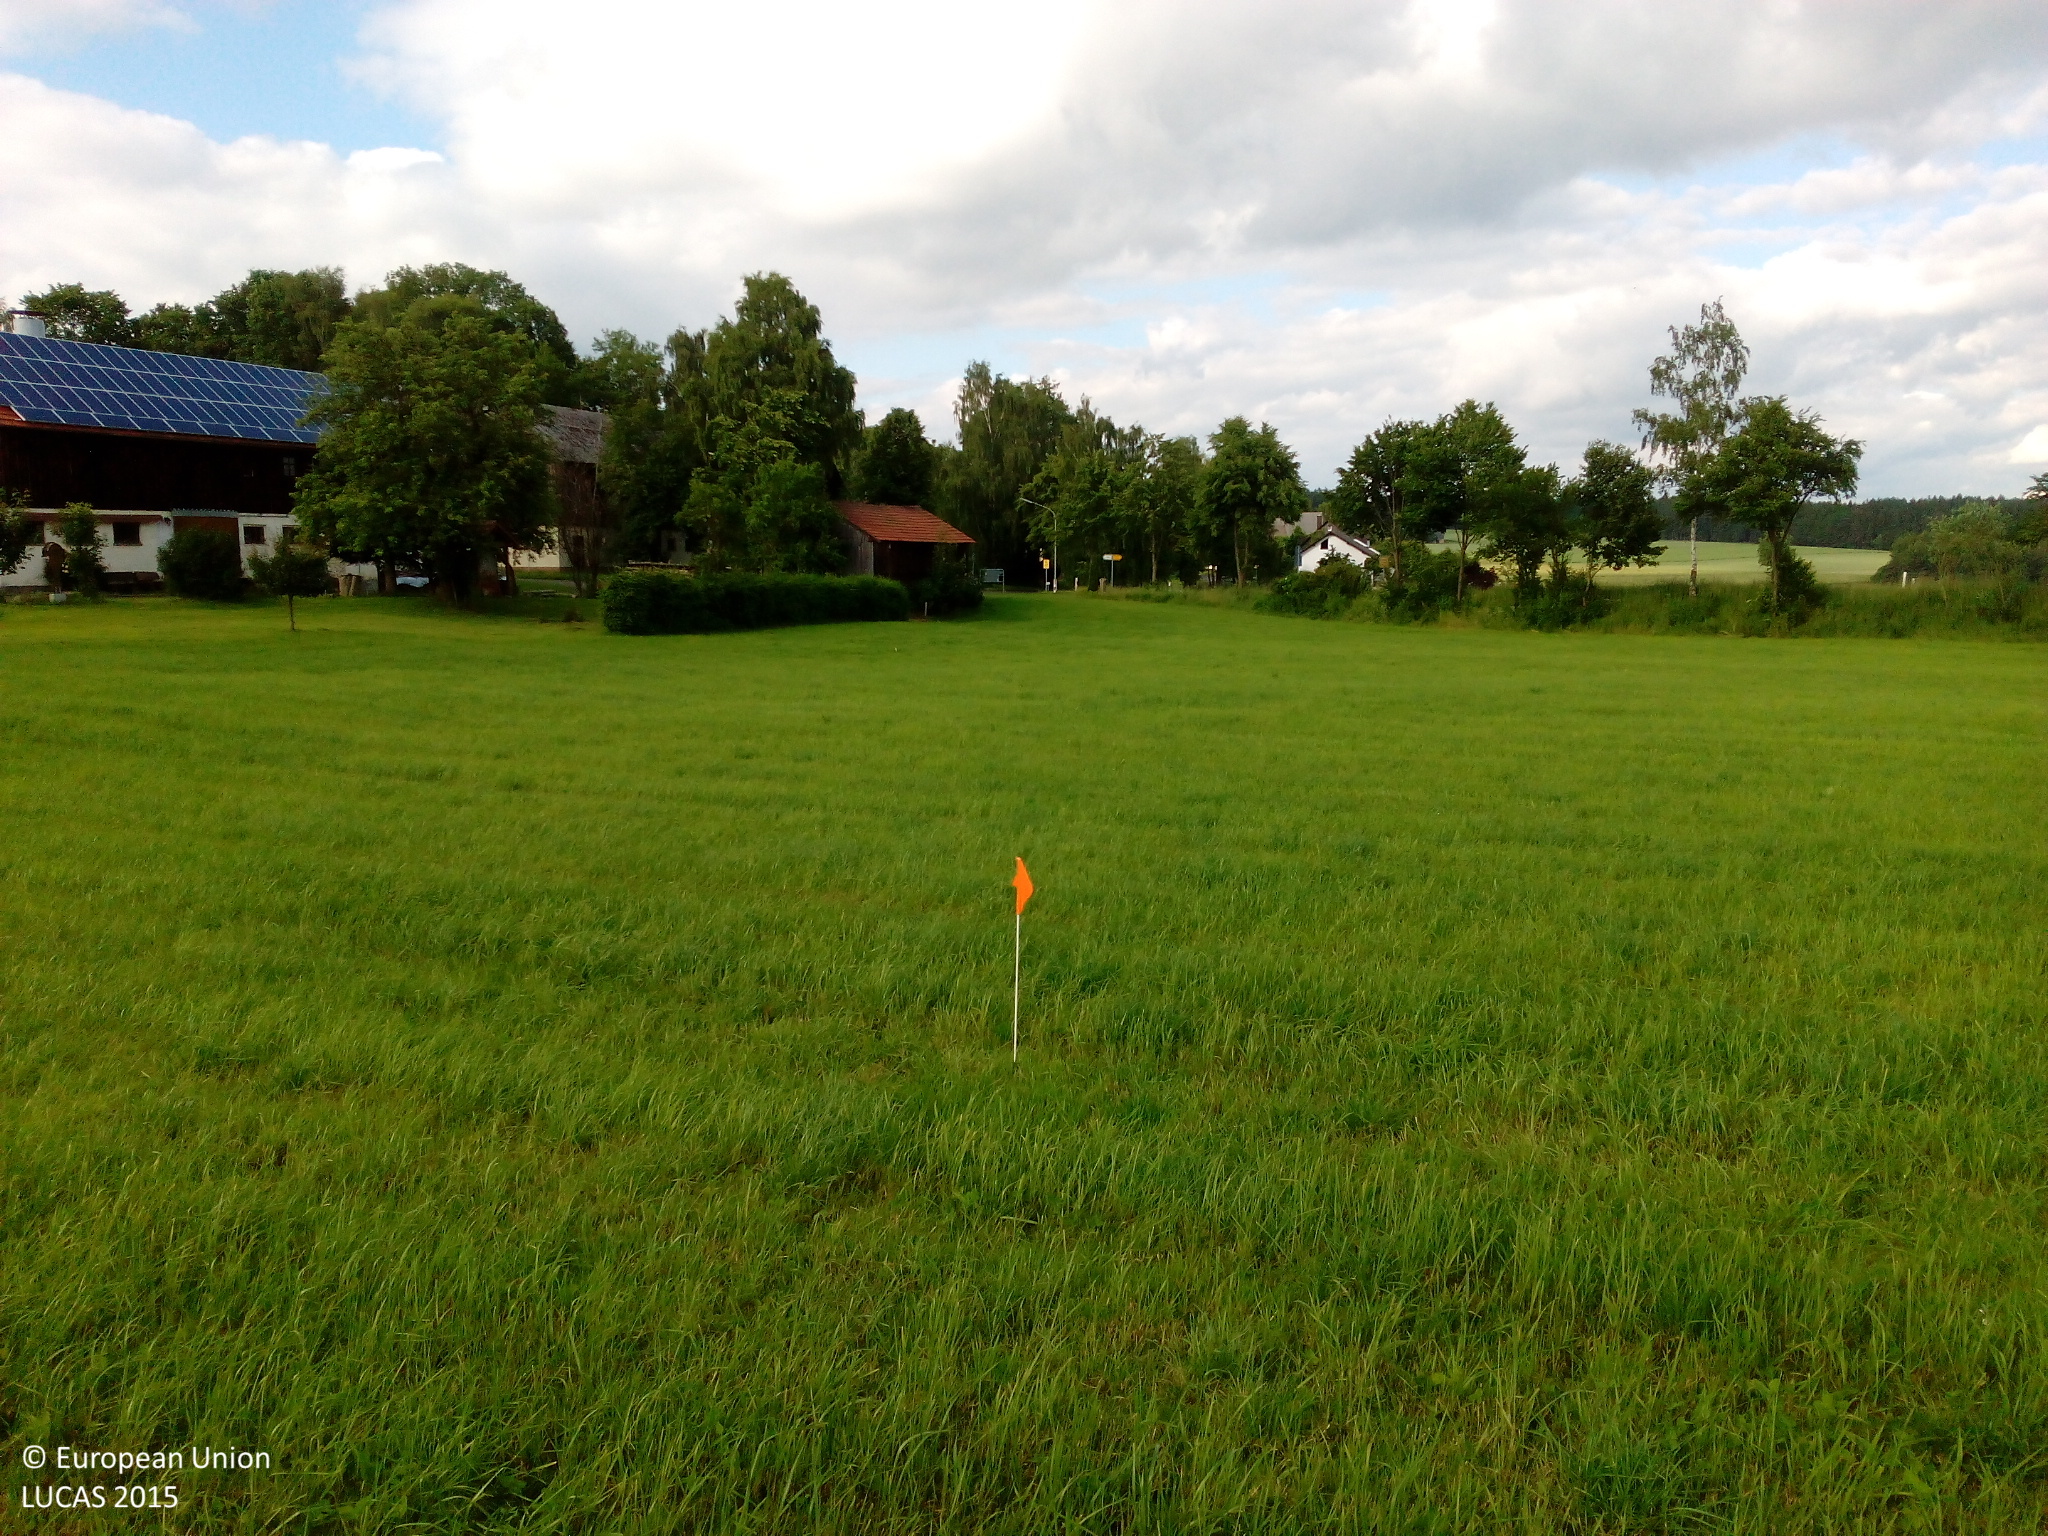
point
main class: Grassland
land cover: Grassland without tree/shrub cover
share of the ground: > 75 %
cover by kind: herbaceous plants 95 %, unconsolidated bare surface 5 %
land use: Agriculture (excluding fallow land and kitchen gardens)
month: June
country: DE
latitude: 50.0182
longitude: 12.2466
